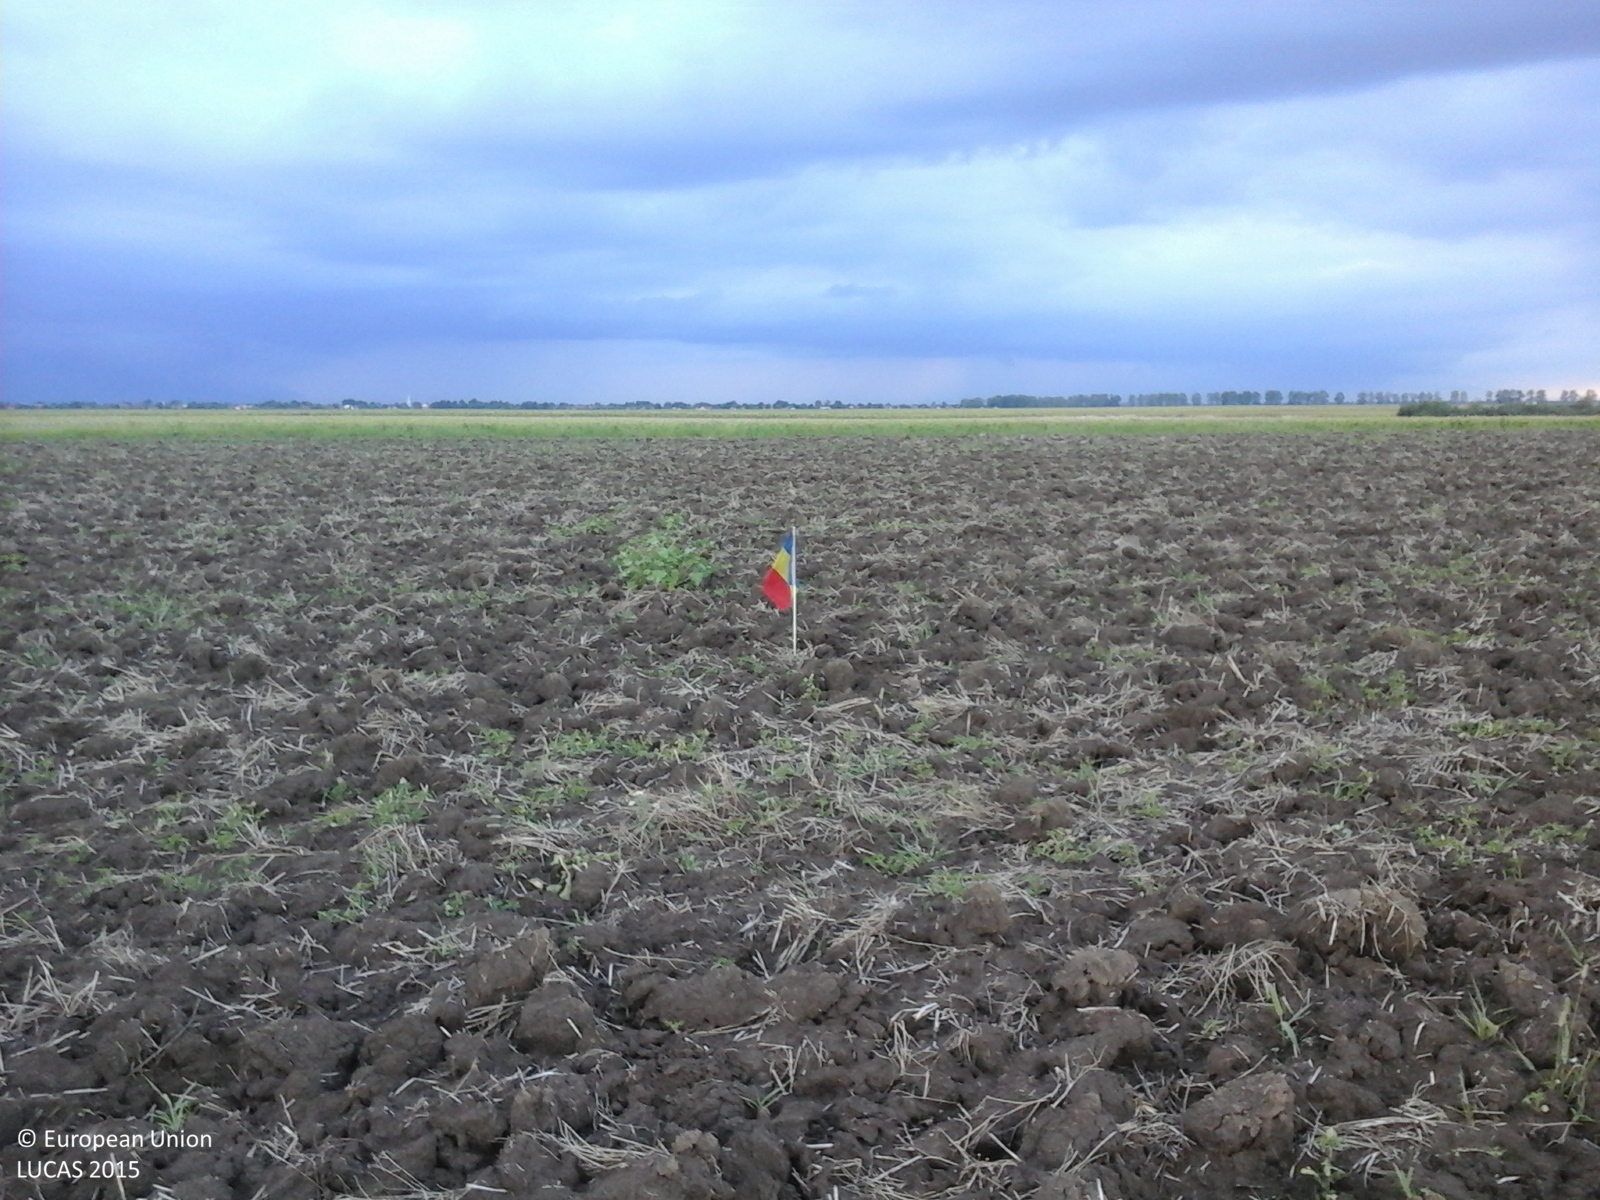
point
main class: Cropland
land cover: Common wheat
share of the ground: < 10 %
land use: Agriculture (excluding fallow land and kitchen gardens)
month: August
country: RO
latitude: 45.6717
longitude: 21.5224
